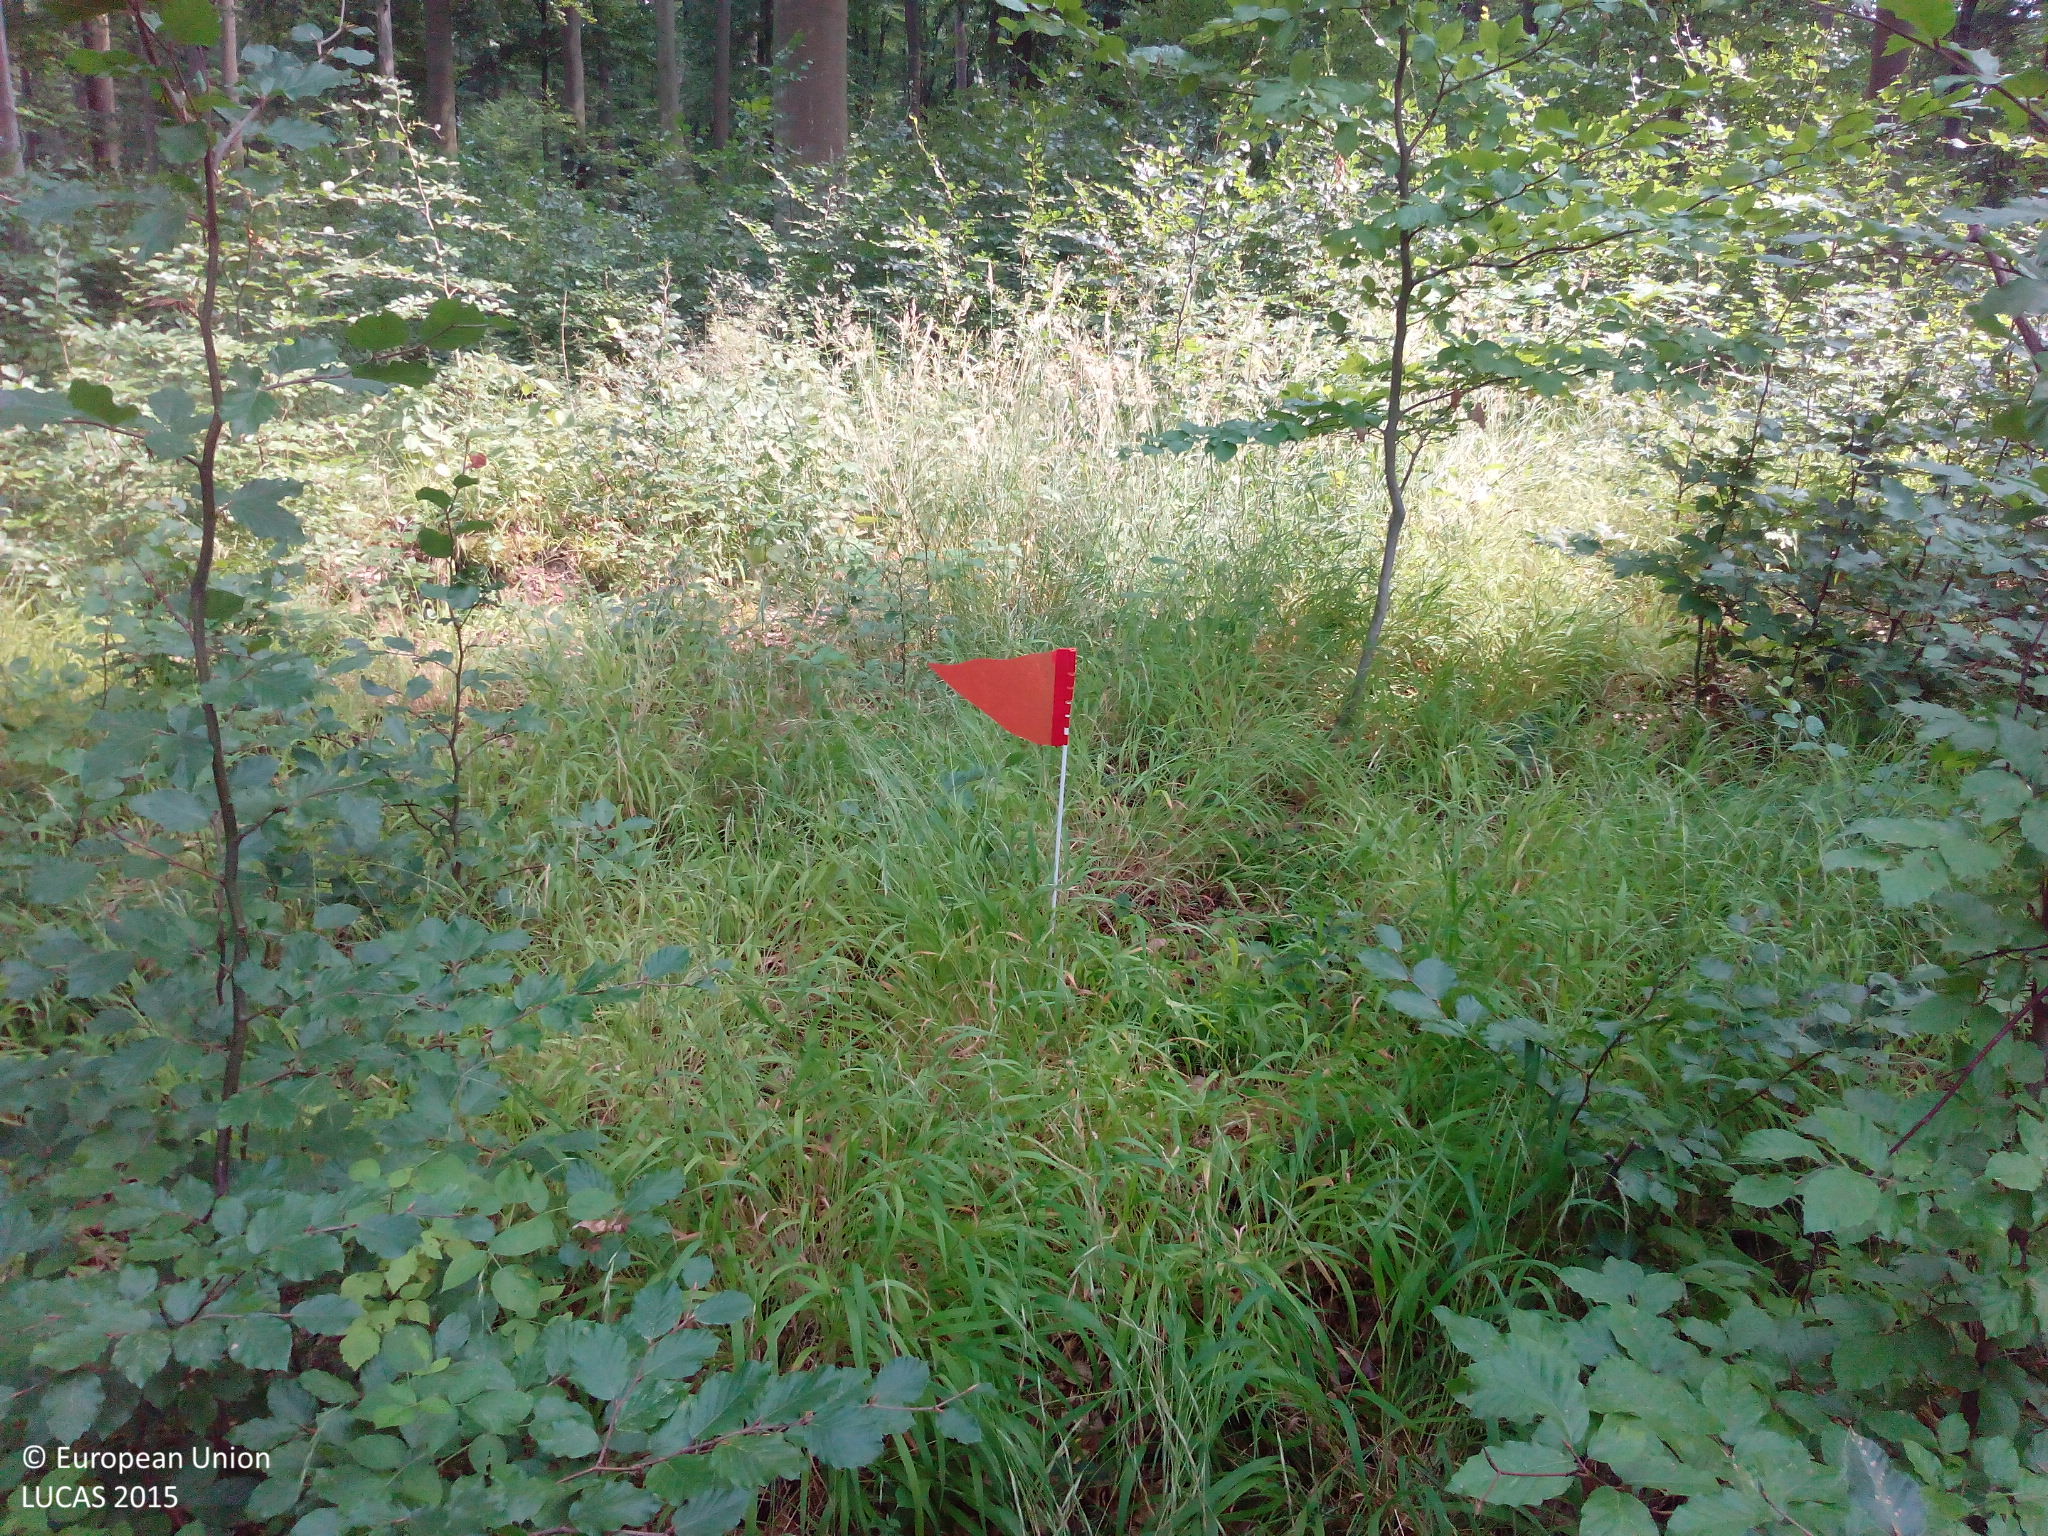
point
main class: Woodland
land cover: Broadleaved woodland
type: beech forest
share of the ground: > 75 %
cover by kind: broadleaved forest trees 70 %, coniferous forest trees 10 %, shrubs 10 %, herbaceous plants 10 %
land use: Forestry
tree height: > 5 m
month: August
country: DE
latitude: 50.2764
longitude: 8.1061
